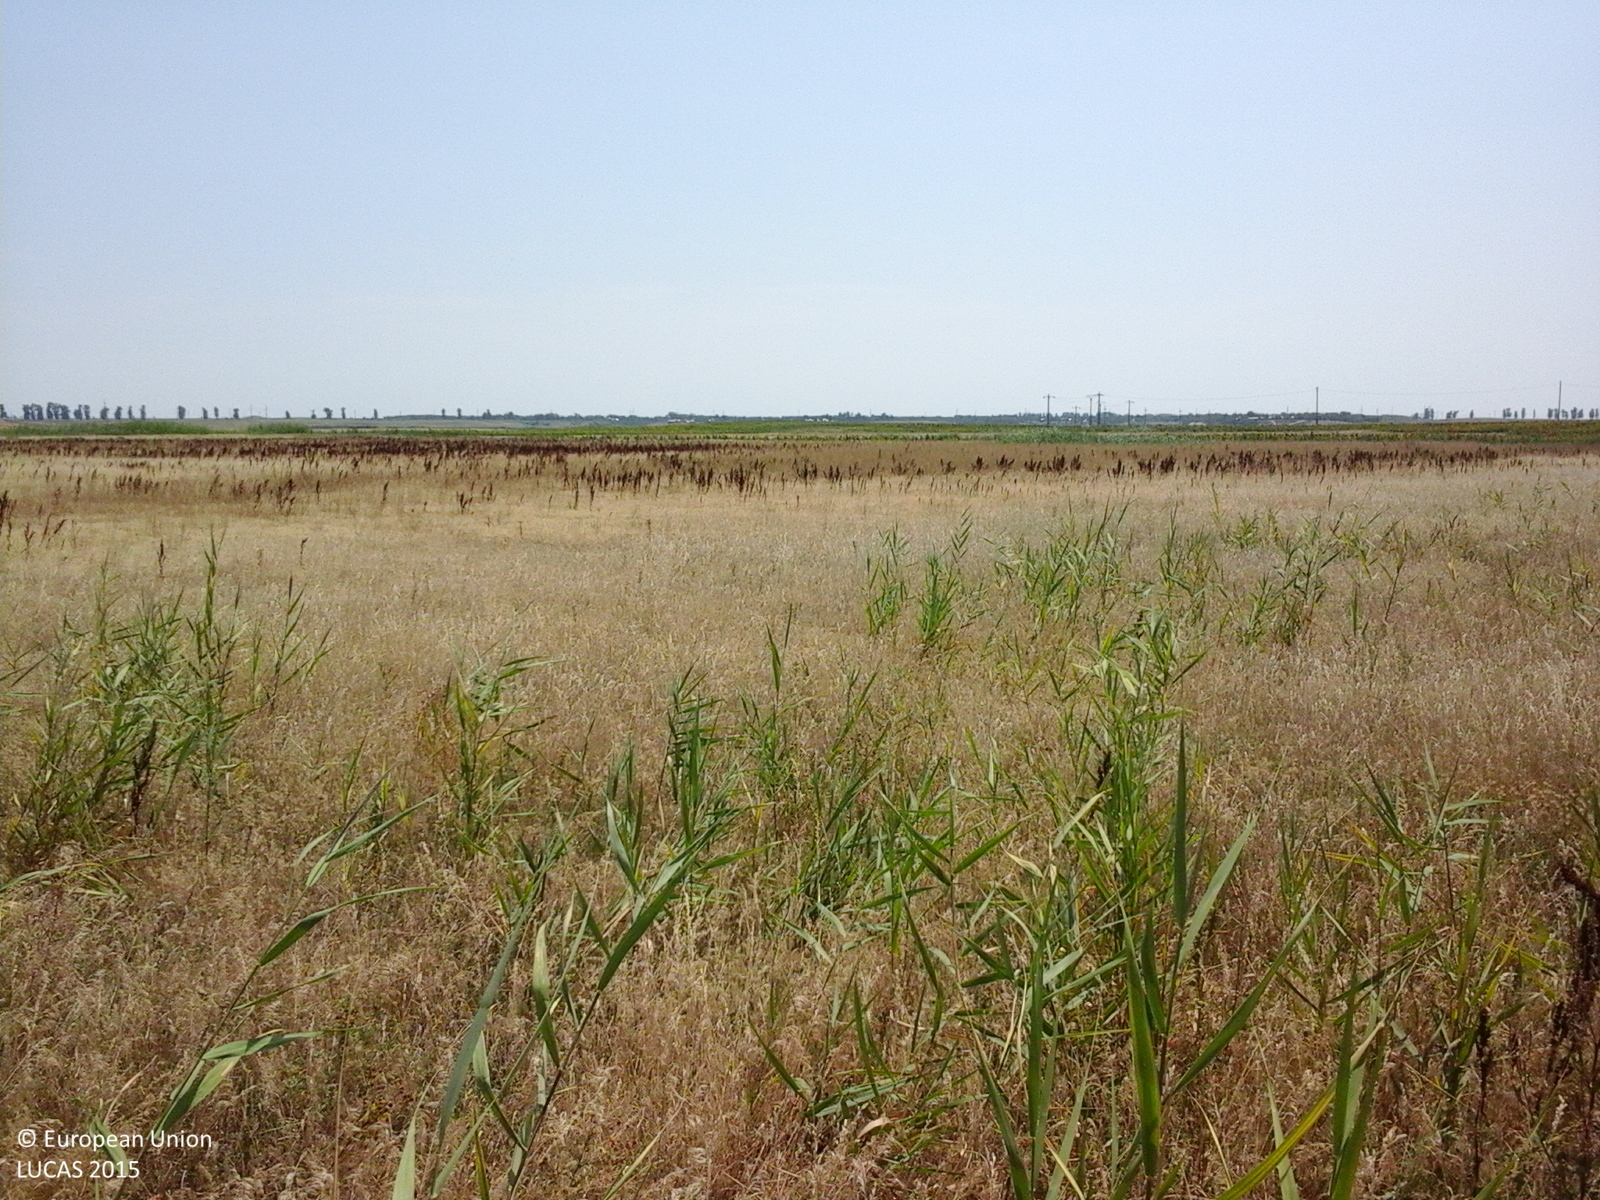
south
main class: Grassland
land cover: Spontaneously vegetated surfaces
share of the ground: > 75 %
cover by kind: herbaceous plants 100 %
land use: Fallow land
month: July
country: RO
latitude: 44.9693
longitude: 27.2709
